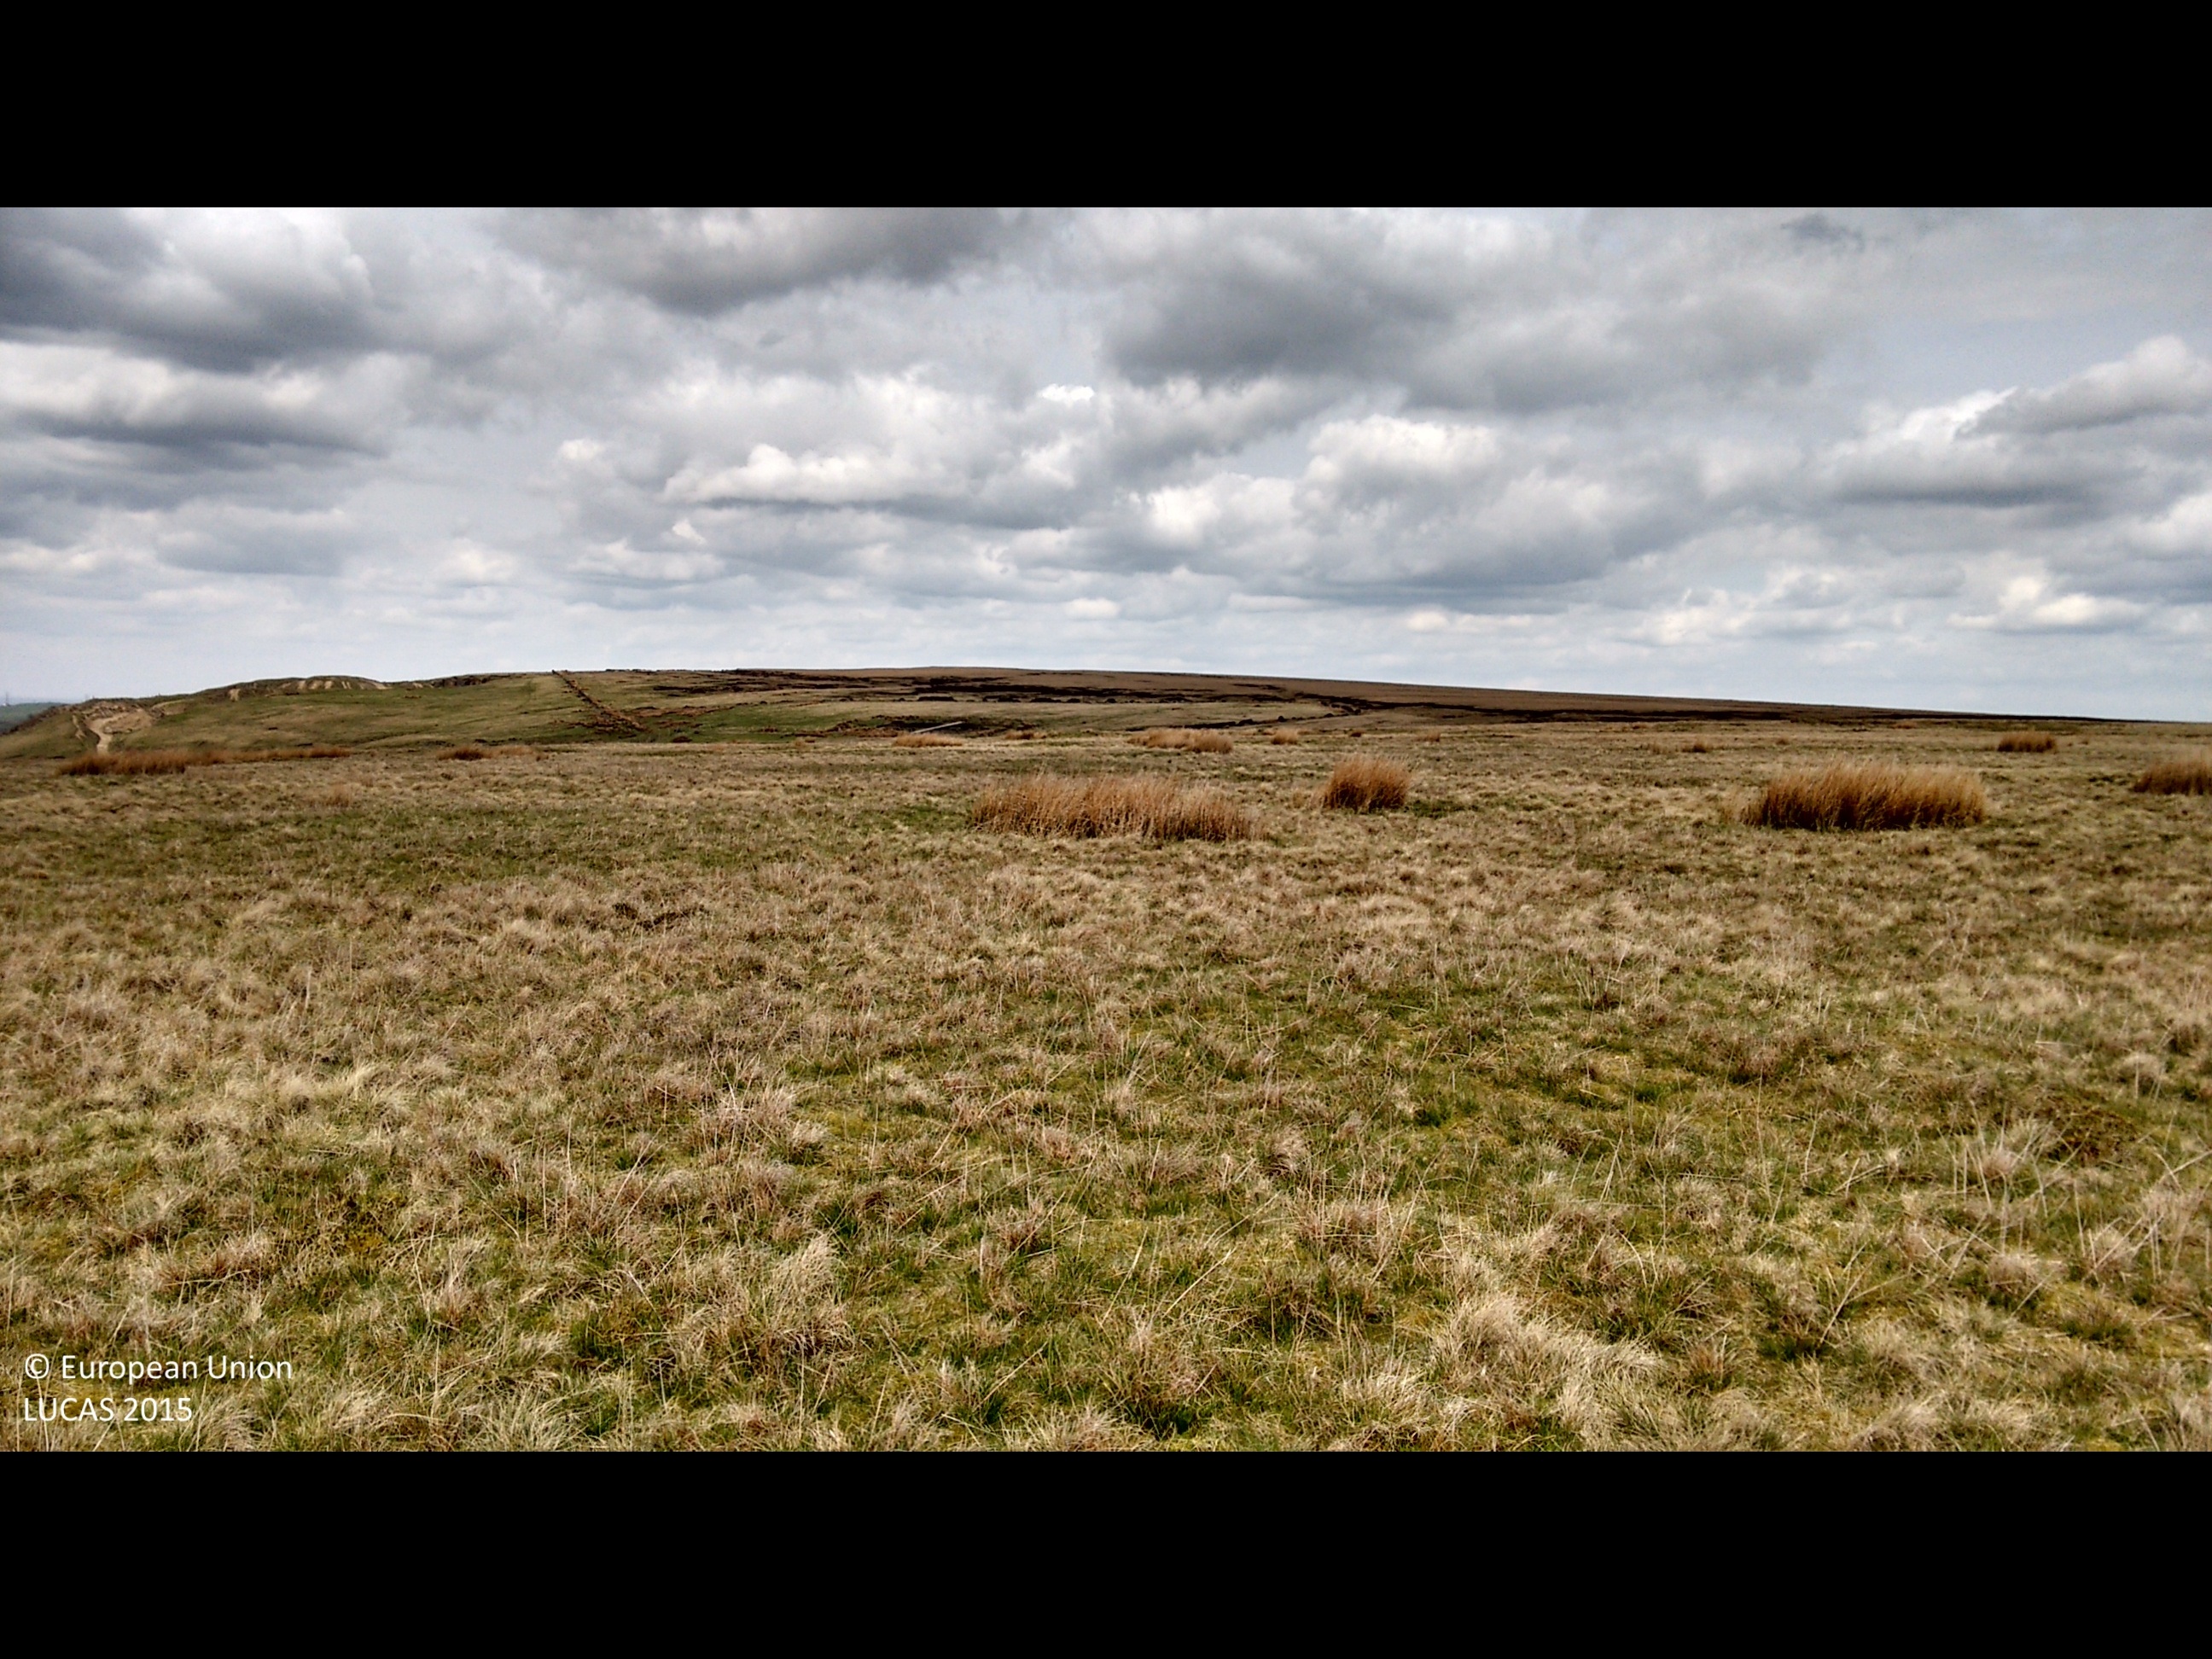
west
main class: Grassland
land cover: Grassland without tree/shrub cover
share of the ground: > 75 %
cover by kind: herbaceous plants 100 %
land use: Agriculture (excluding fallow land and kitchen gardens)
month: May
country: GB
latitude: 53.6570
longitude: -2.3649
